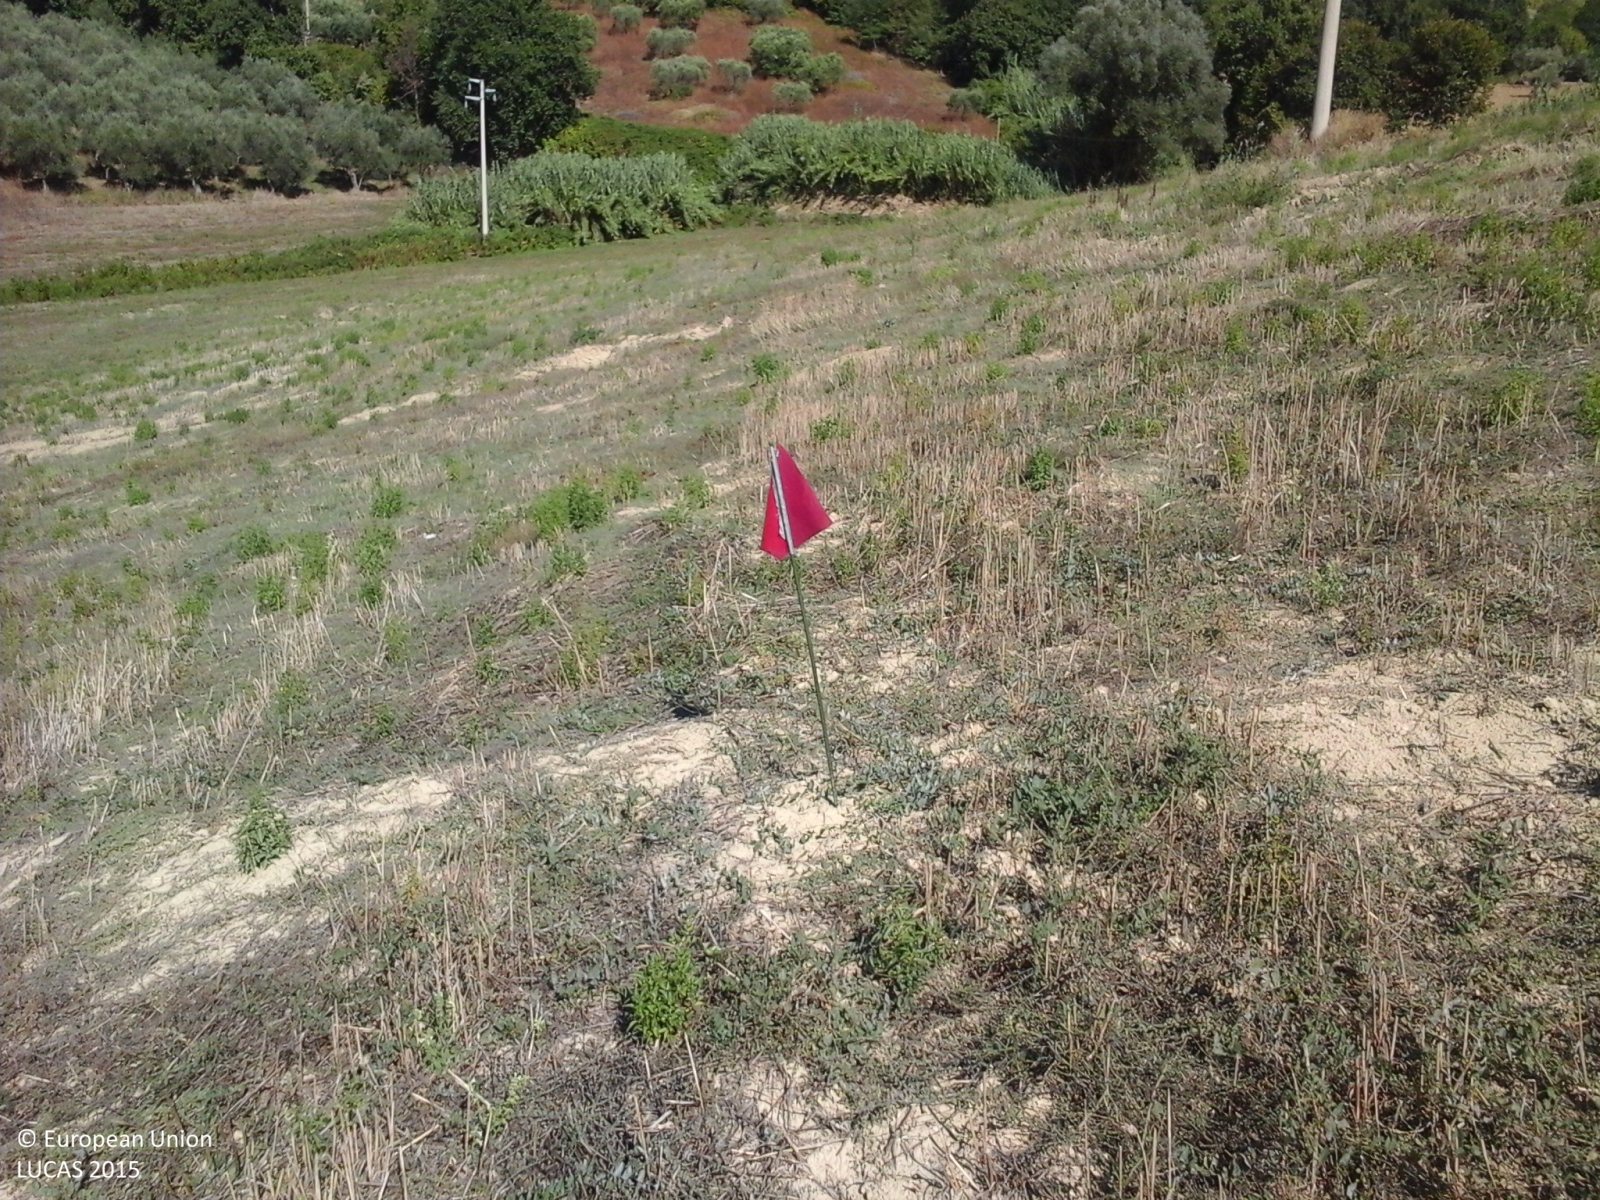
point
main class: Grassland
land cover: Spontaneously vegetated surfaces
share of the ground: > 75 %
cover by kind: herbaceous plants 80 %, unconsolidated bare surface 20 %
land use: Agriculture (excluding fallow land and kitchen gardens)
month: September
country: IT
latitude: 43.8209
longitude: 12.9647
